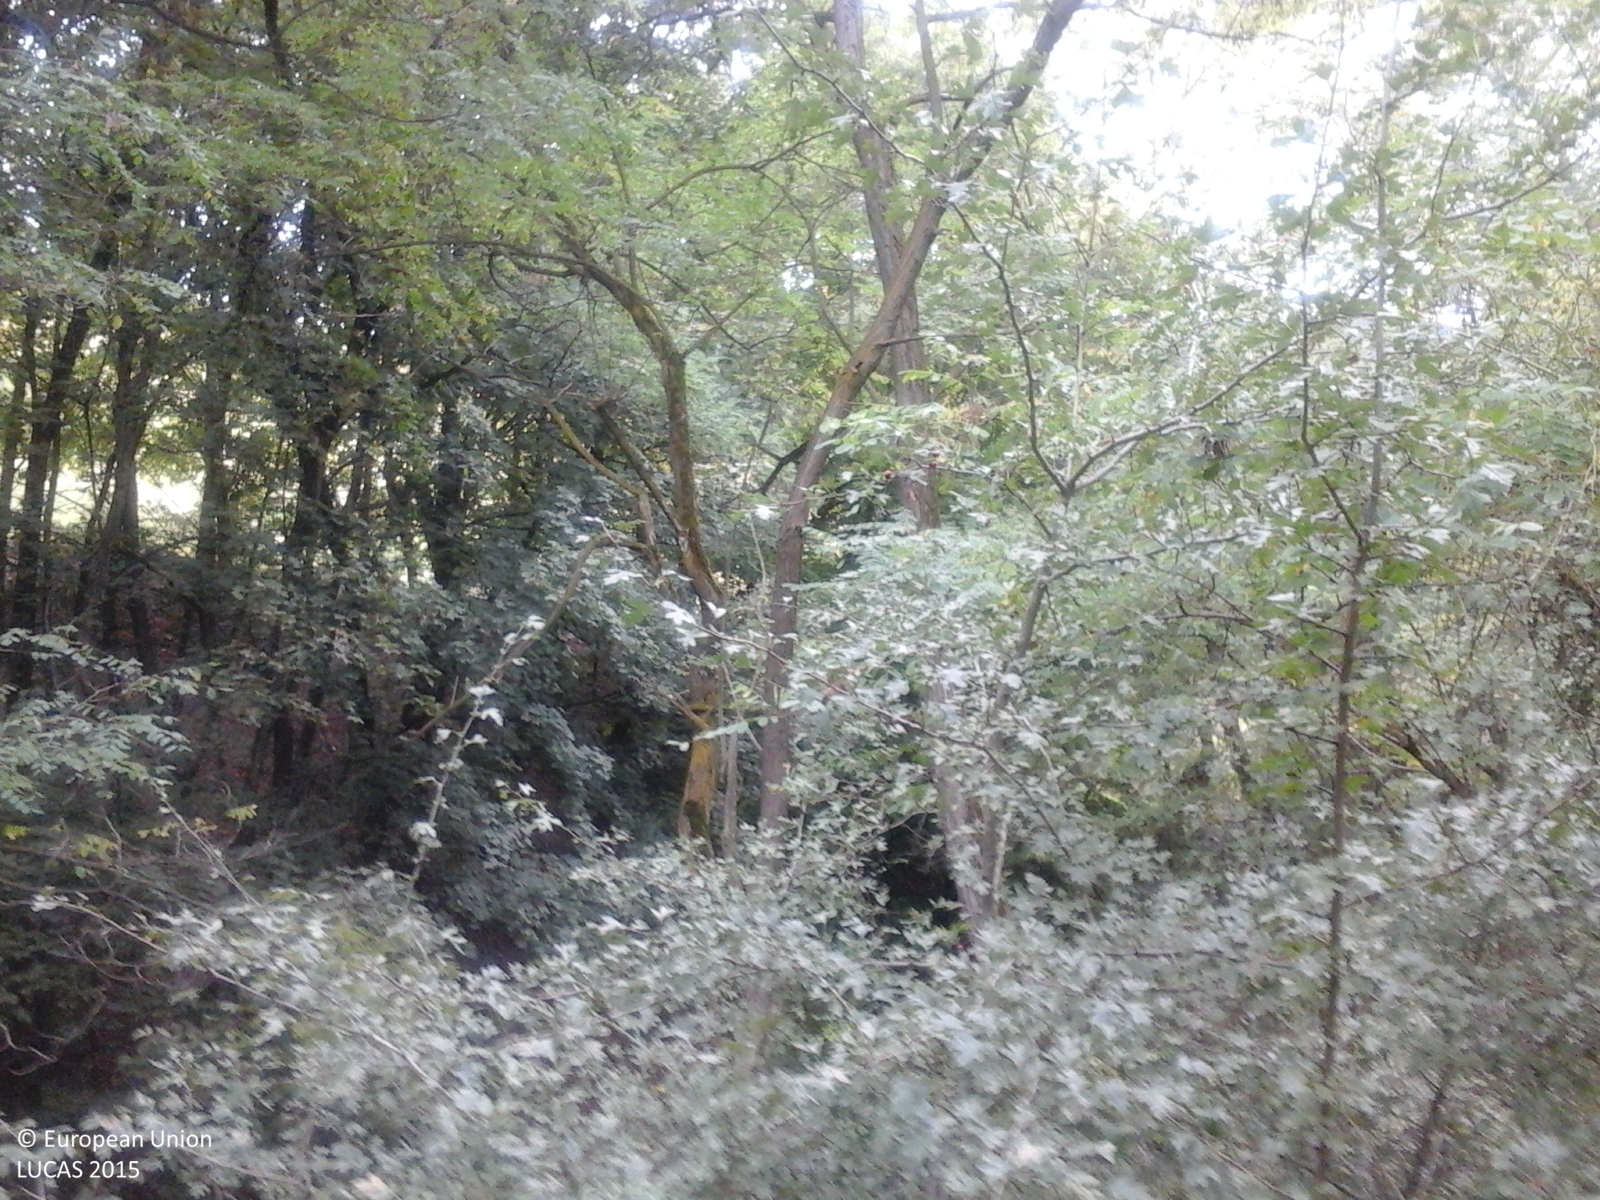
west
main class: Woodland
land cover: Broadleaved woodland
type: exotic forest
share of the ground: > 75 %
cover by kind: broadleaved forest trees 100 %
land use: Forestry
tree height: > 5 m
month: October
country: RO
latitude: 46.0460
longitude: 23.4392
